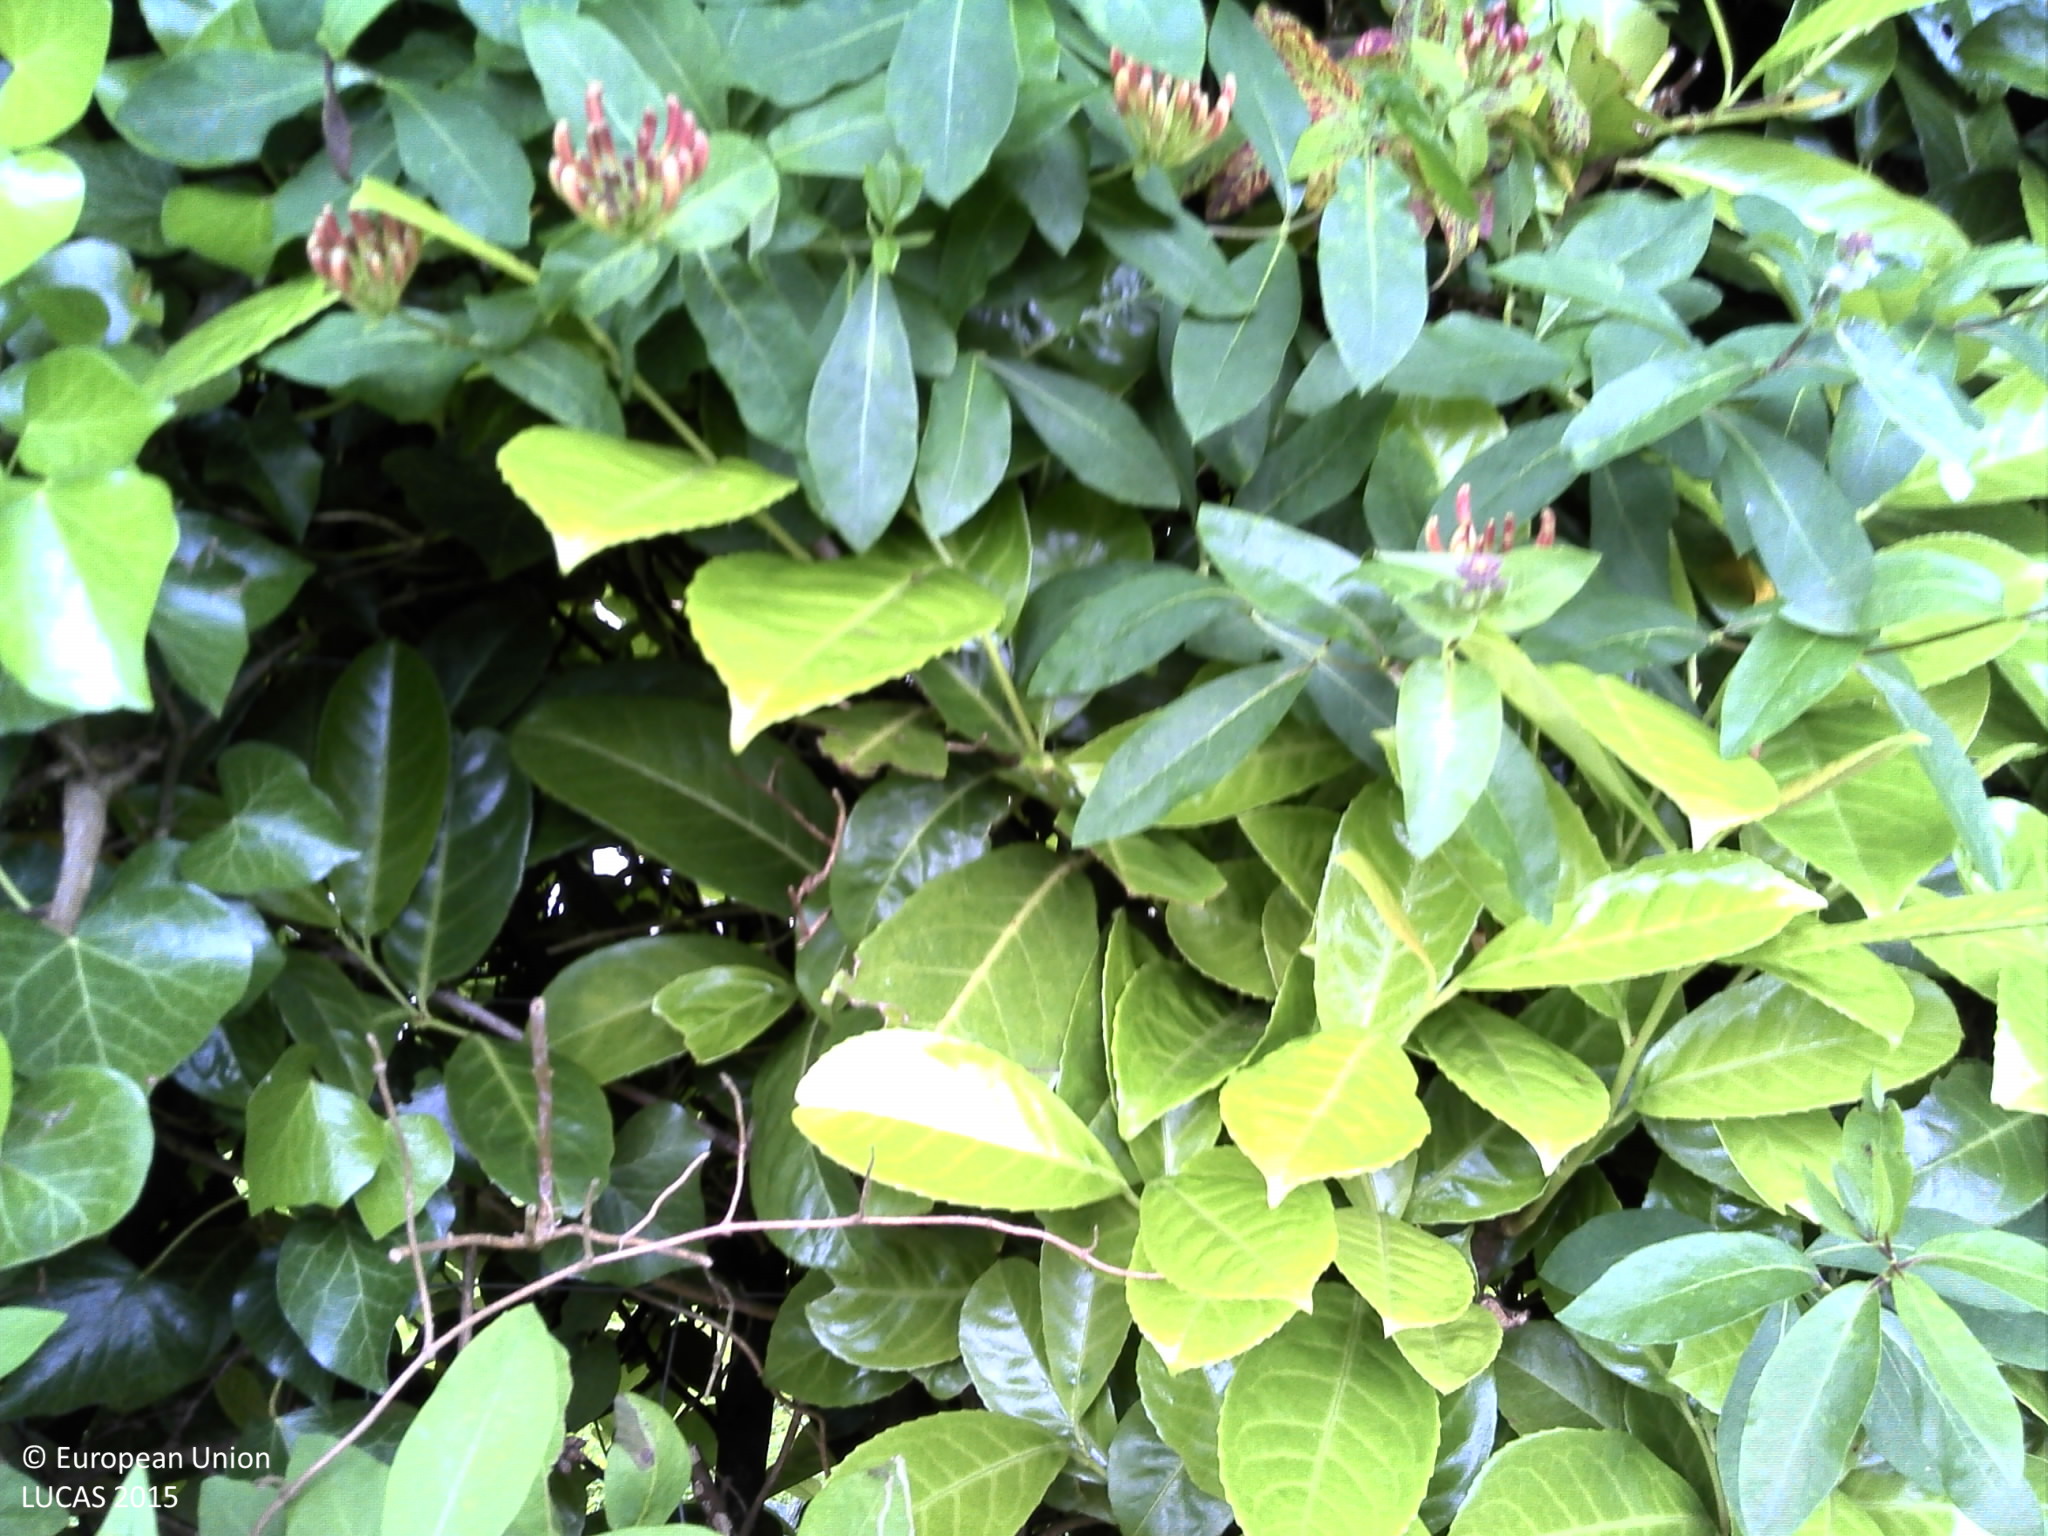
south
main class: Cropland
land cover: Maize
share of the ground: 10 - 25 %
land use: Agriculture (excluding fallow land and kitchen gardens)
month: June
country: FR
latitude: 47.8163
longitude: -3.5794
